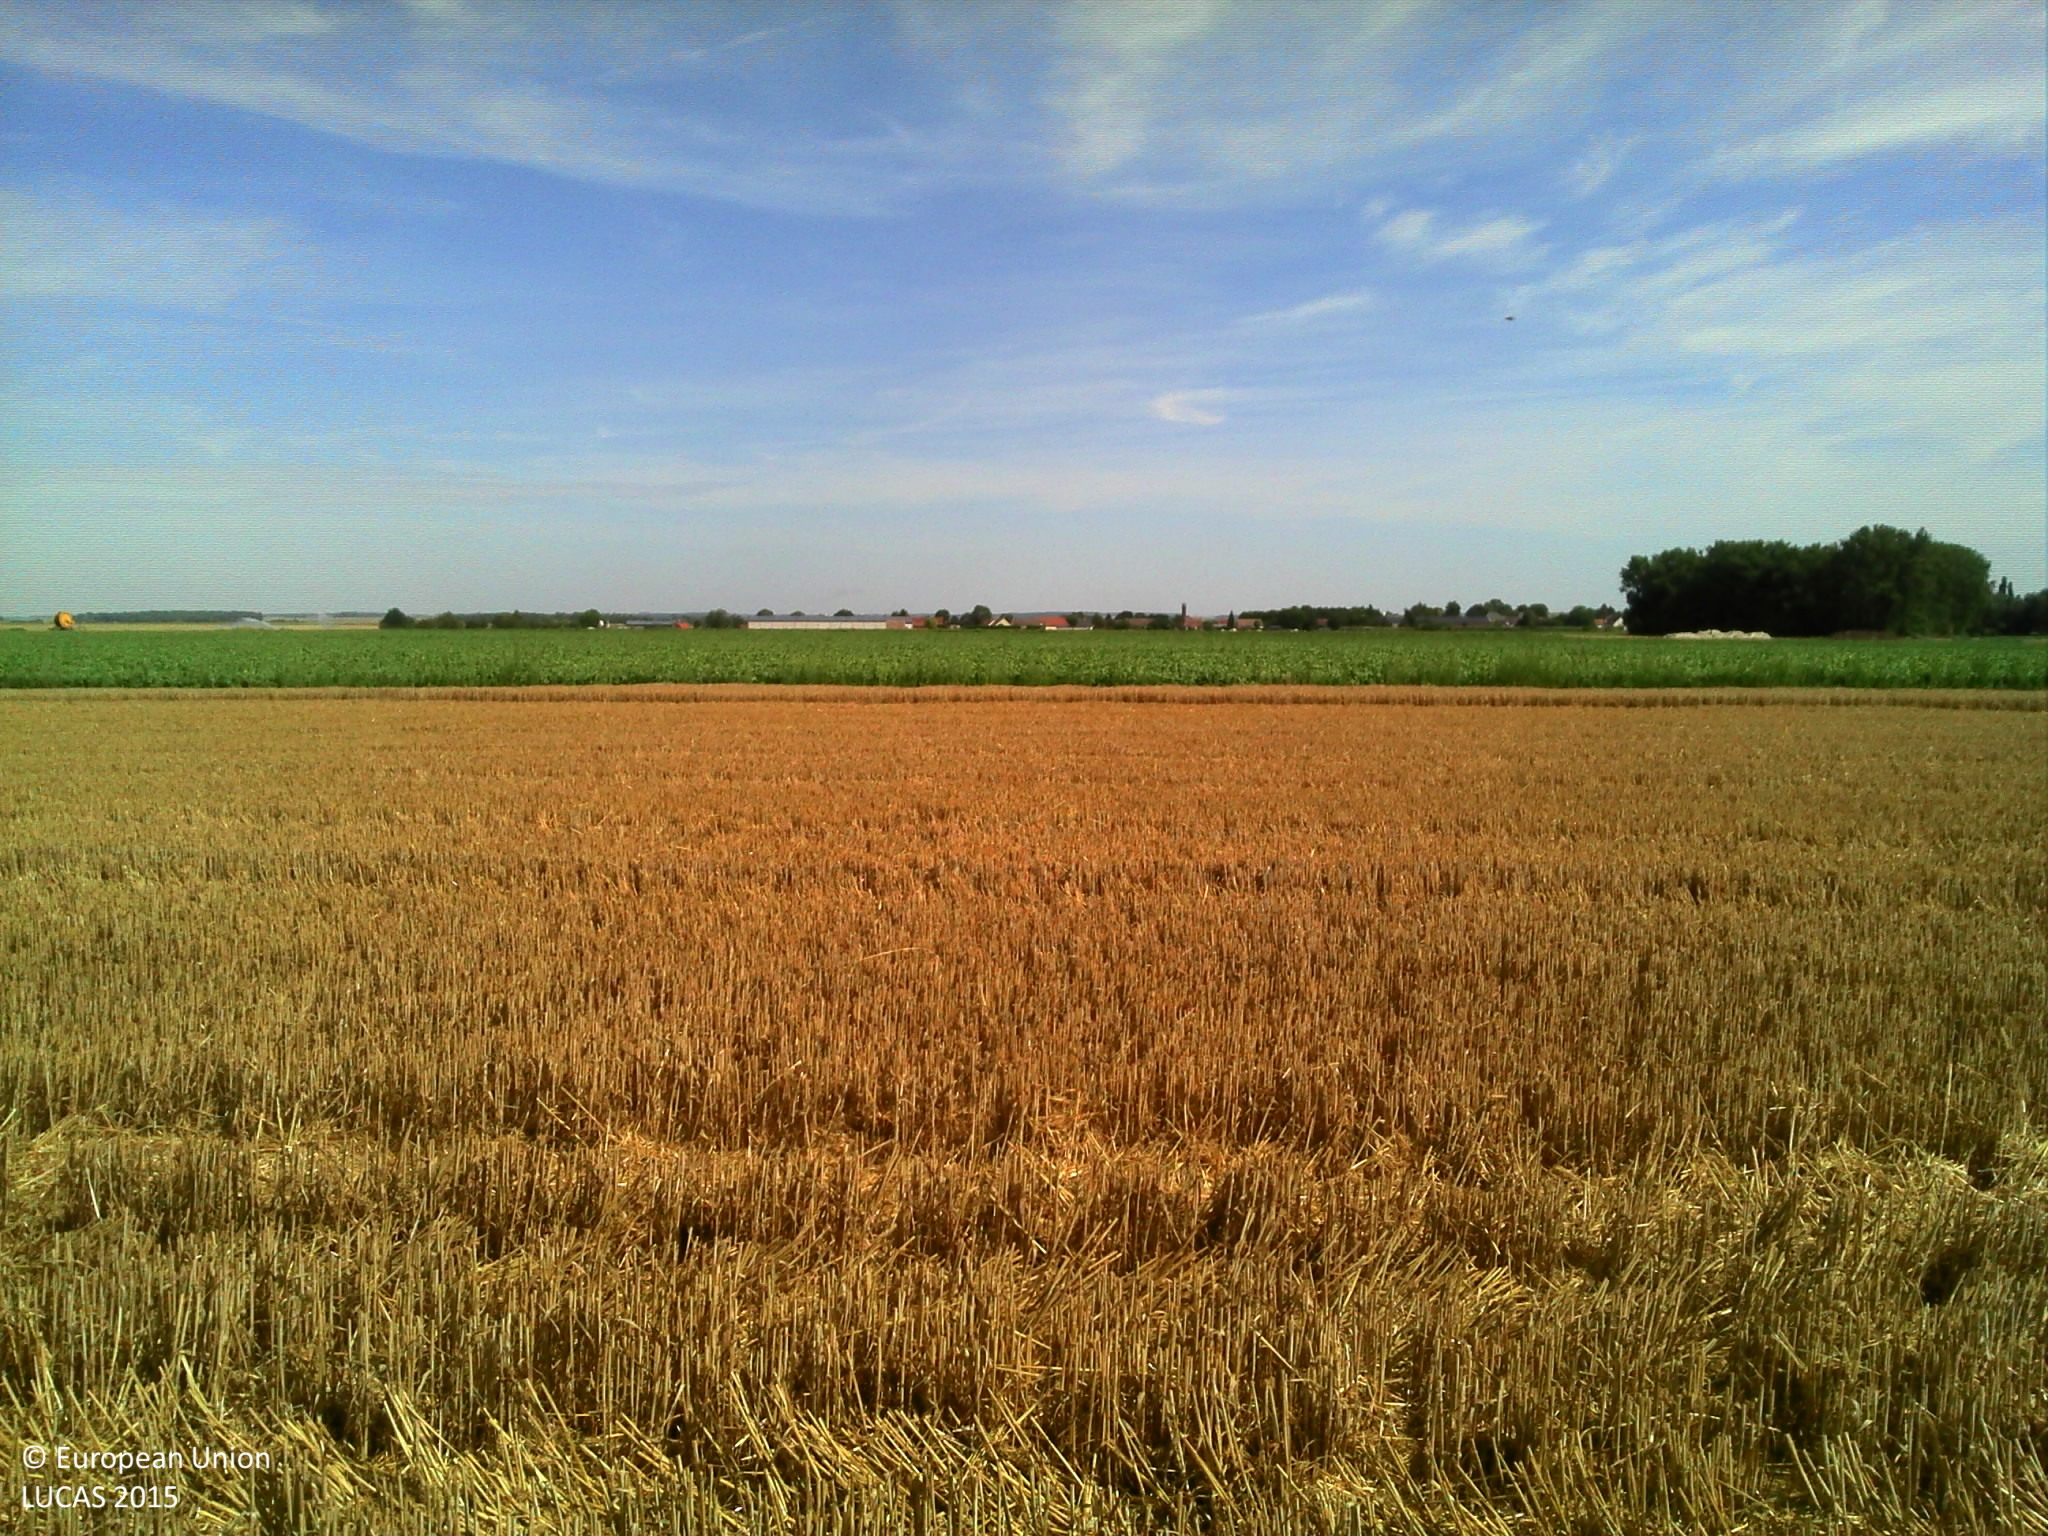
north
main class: Cropland
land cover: Common wheat
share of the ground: > 75 %
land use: Agriculture (excluding fallow land and kitchen gardens)
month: August
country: FR
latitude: 49.8642
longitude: 2.7689
